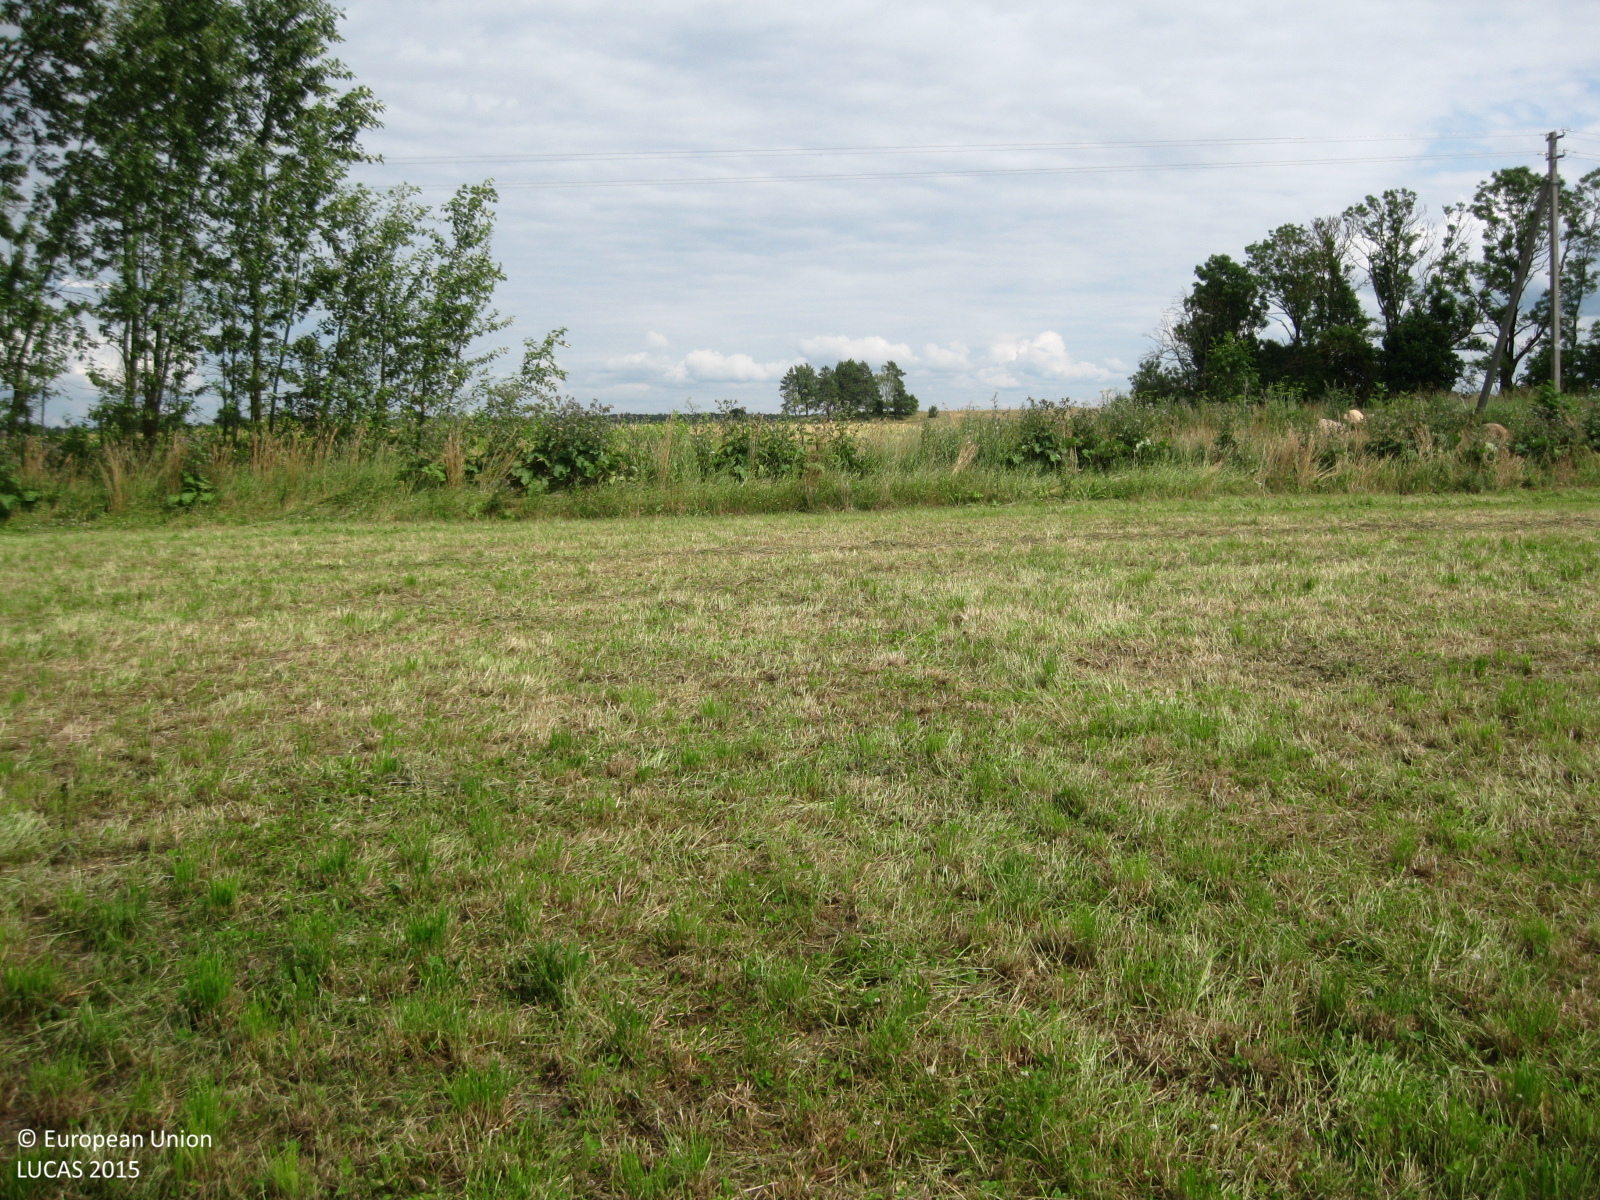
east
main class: Grassland
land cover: Grassland without tree/shrub cover
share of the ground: > 75 %
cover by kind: herbaceous plants 100 %
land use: Agriculture (excluding fallow land and kitchen gardens)
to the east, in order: Grassland without tree/shrub cover; Shruby margins; Paved roads, cycling and walking lanes; Broadleaved woodland; Triticale; Grassland without tree/shrub cover
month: July
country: LT
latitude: 55.5924
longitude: 24.6867
